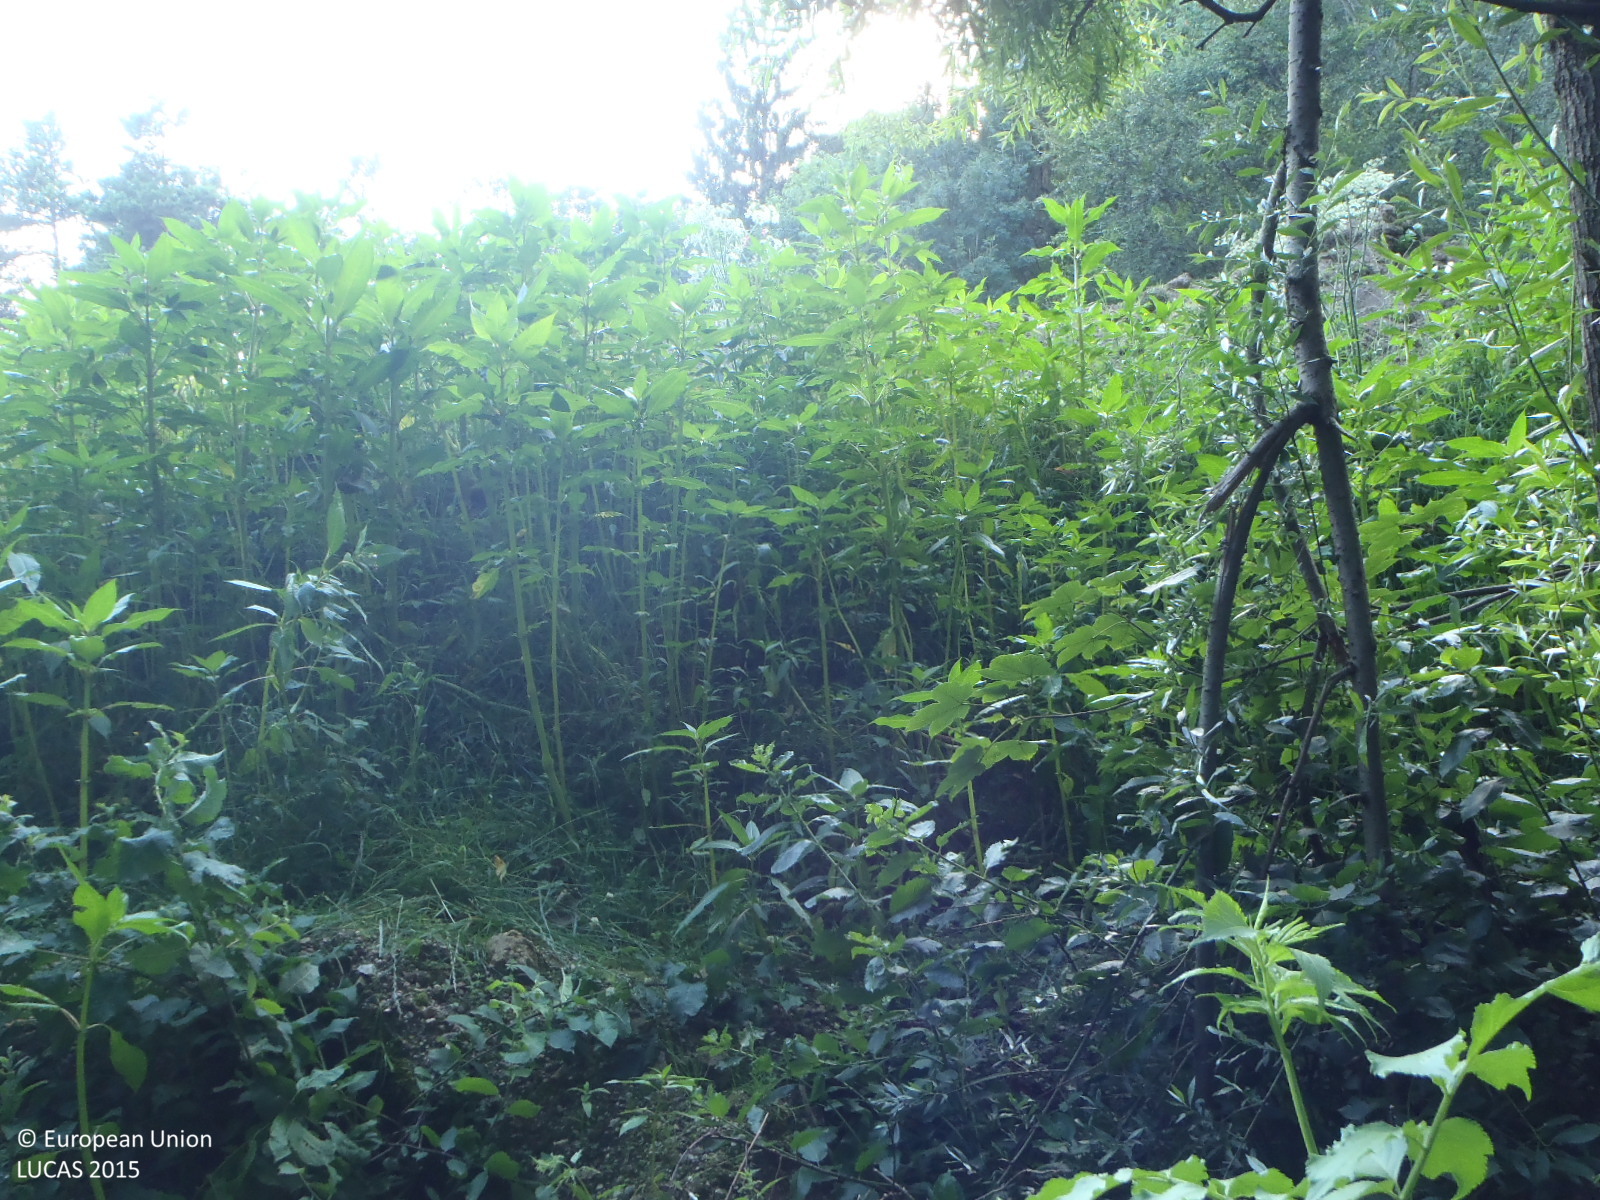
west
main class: Woodland
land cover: Broadleaved woodland
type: mountainous beech forest
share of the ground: > 75 %
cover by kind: broadleaved forest trees 60 %, coniferous forest trees 20 %, herbaceous plants 15 %, shrubs 5 %
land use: Forestry
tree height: > 5 m
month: July
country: AT
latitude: 47.5552
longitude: 12.1115
